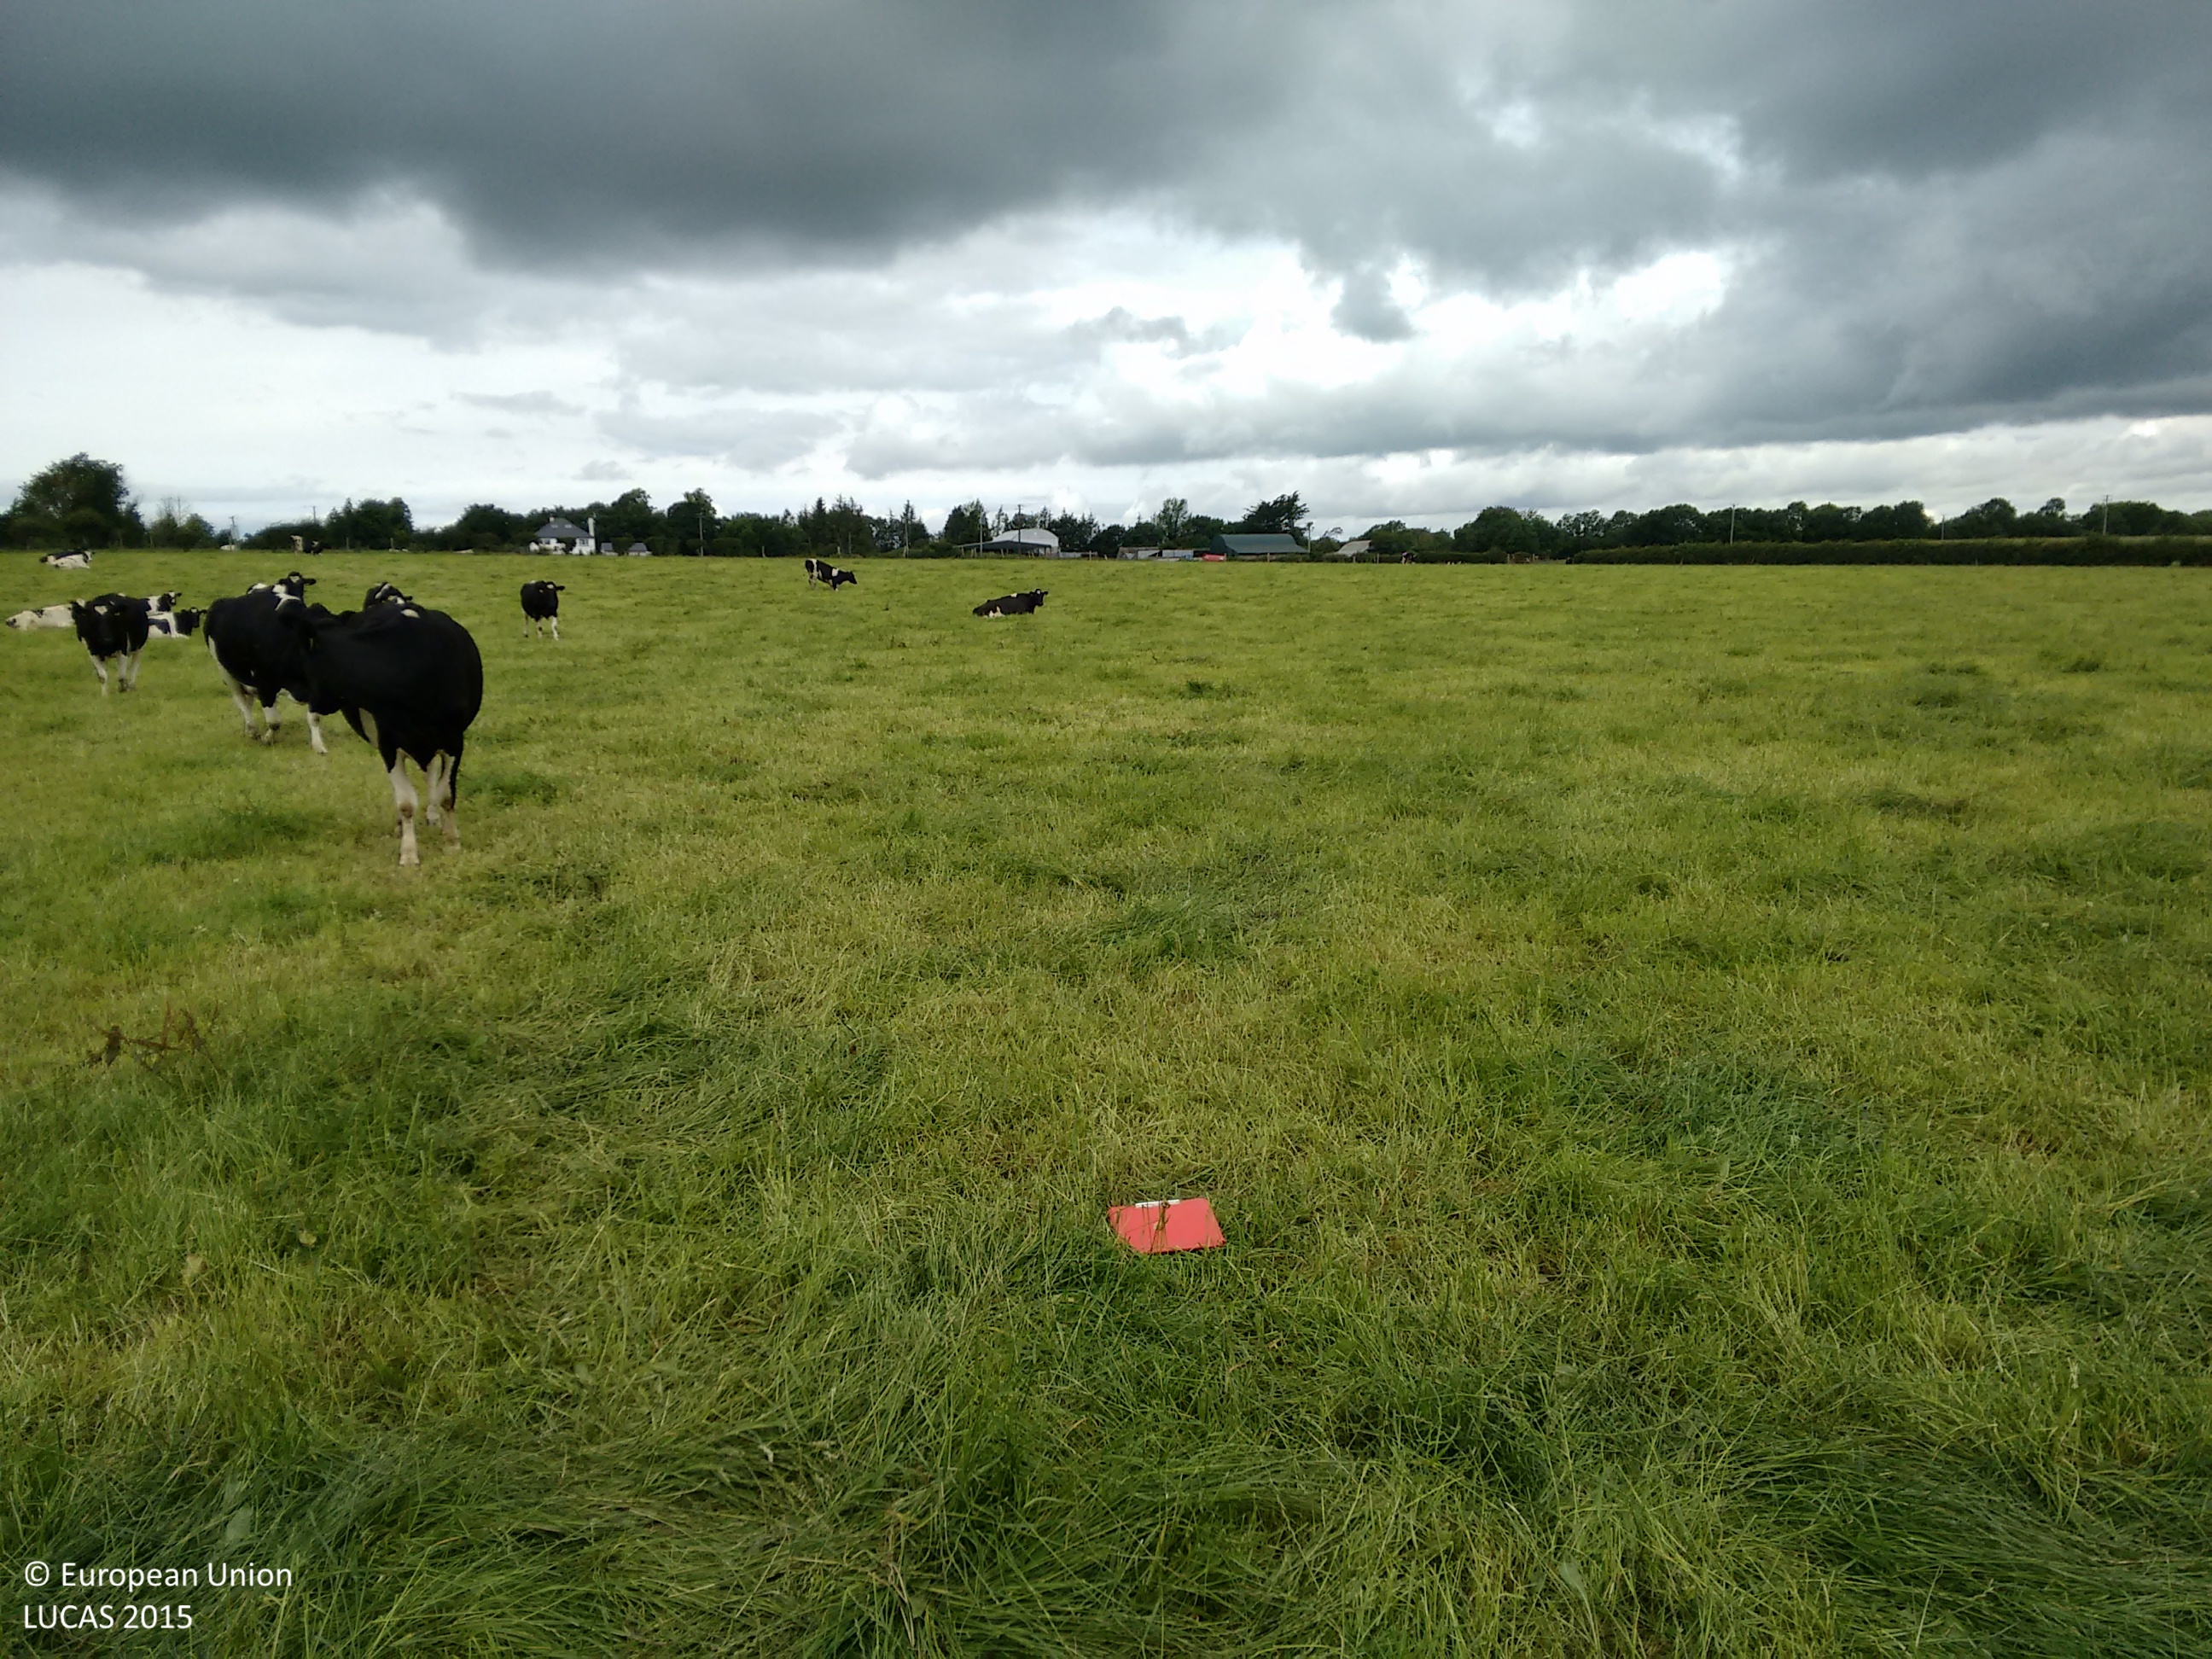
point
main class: Grassland
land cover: Grassland without tree/shrub cover
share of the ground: > 75 %
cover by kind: herbaceous plants 100 %
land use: Agriculture (excluding fallow land and kitchen gardens)
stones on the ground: < 10 %
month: July
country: IE
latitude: 52.6253
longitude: -7.2733
